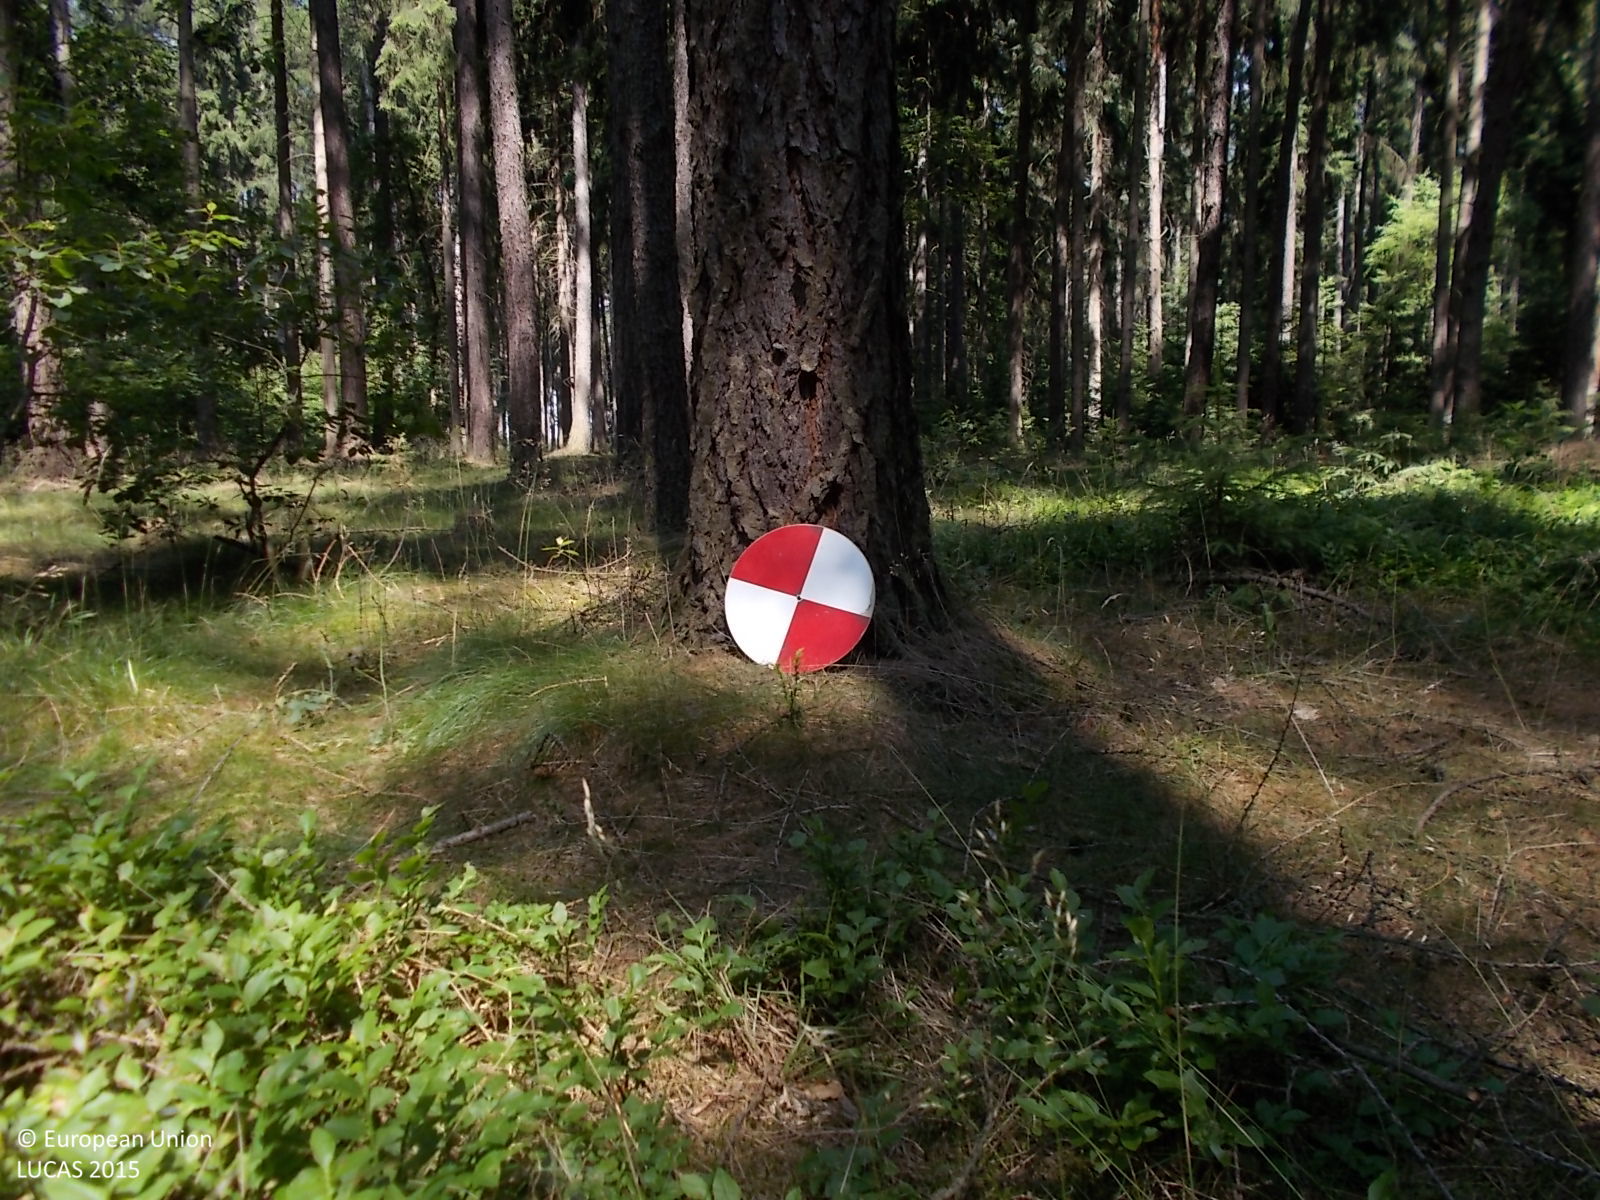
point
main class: Woodland
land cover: Other coniferous woodland
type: hemiboreal forest and nemoral coniferous forest and mixed broadleaved-coniferous forest
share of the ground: > 75 %
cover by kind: coniferous forest trees 75 %, herbaceous plants 10 %, lichens and mosses 10 %, shrubs 5 %
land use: Forestry
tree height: > 5 m
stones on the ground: < 10 %
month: July
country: CZ
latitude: 50.2110
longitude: 13.7981
